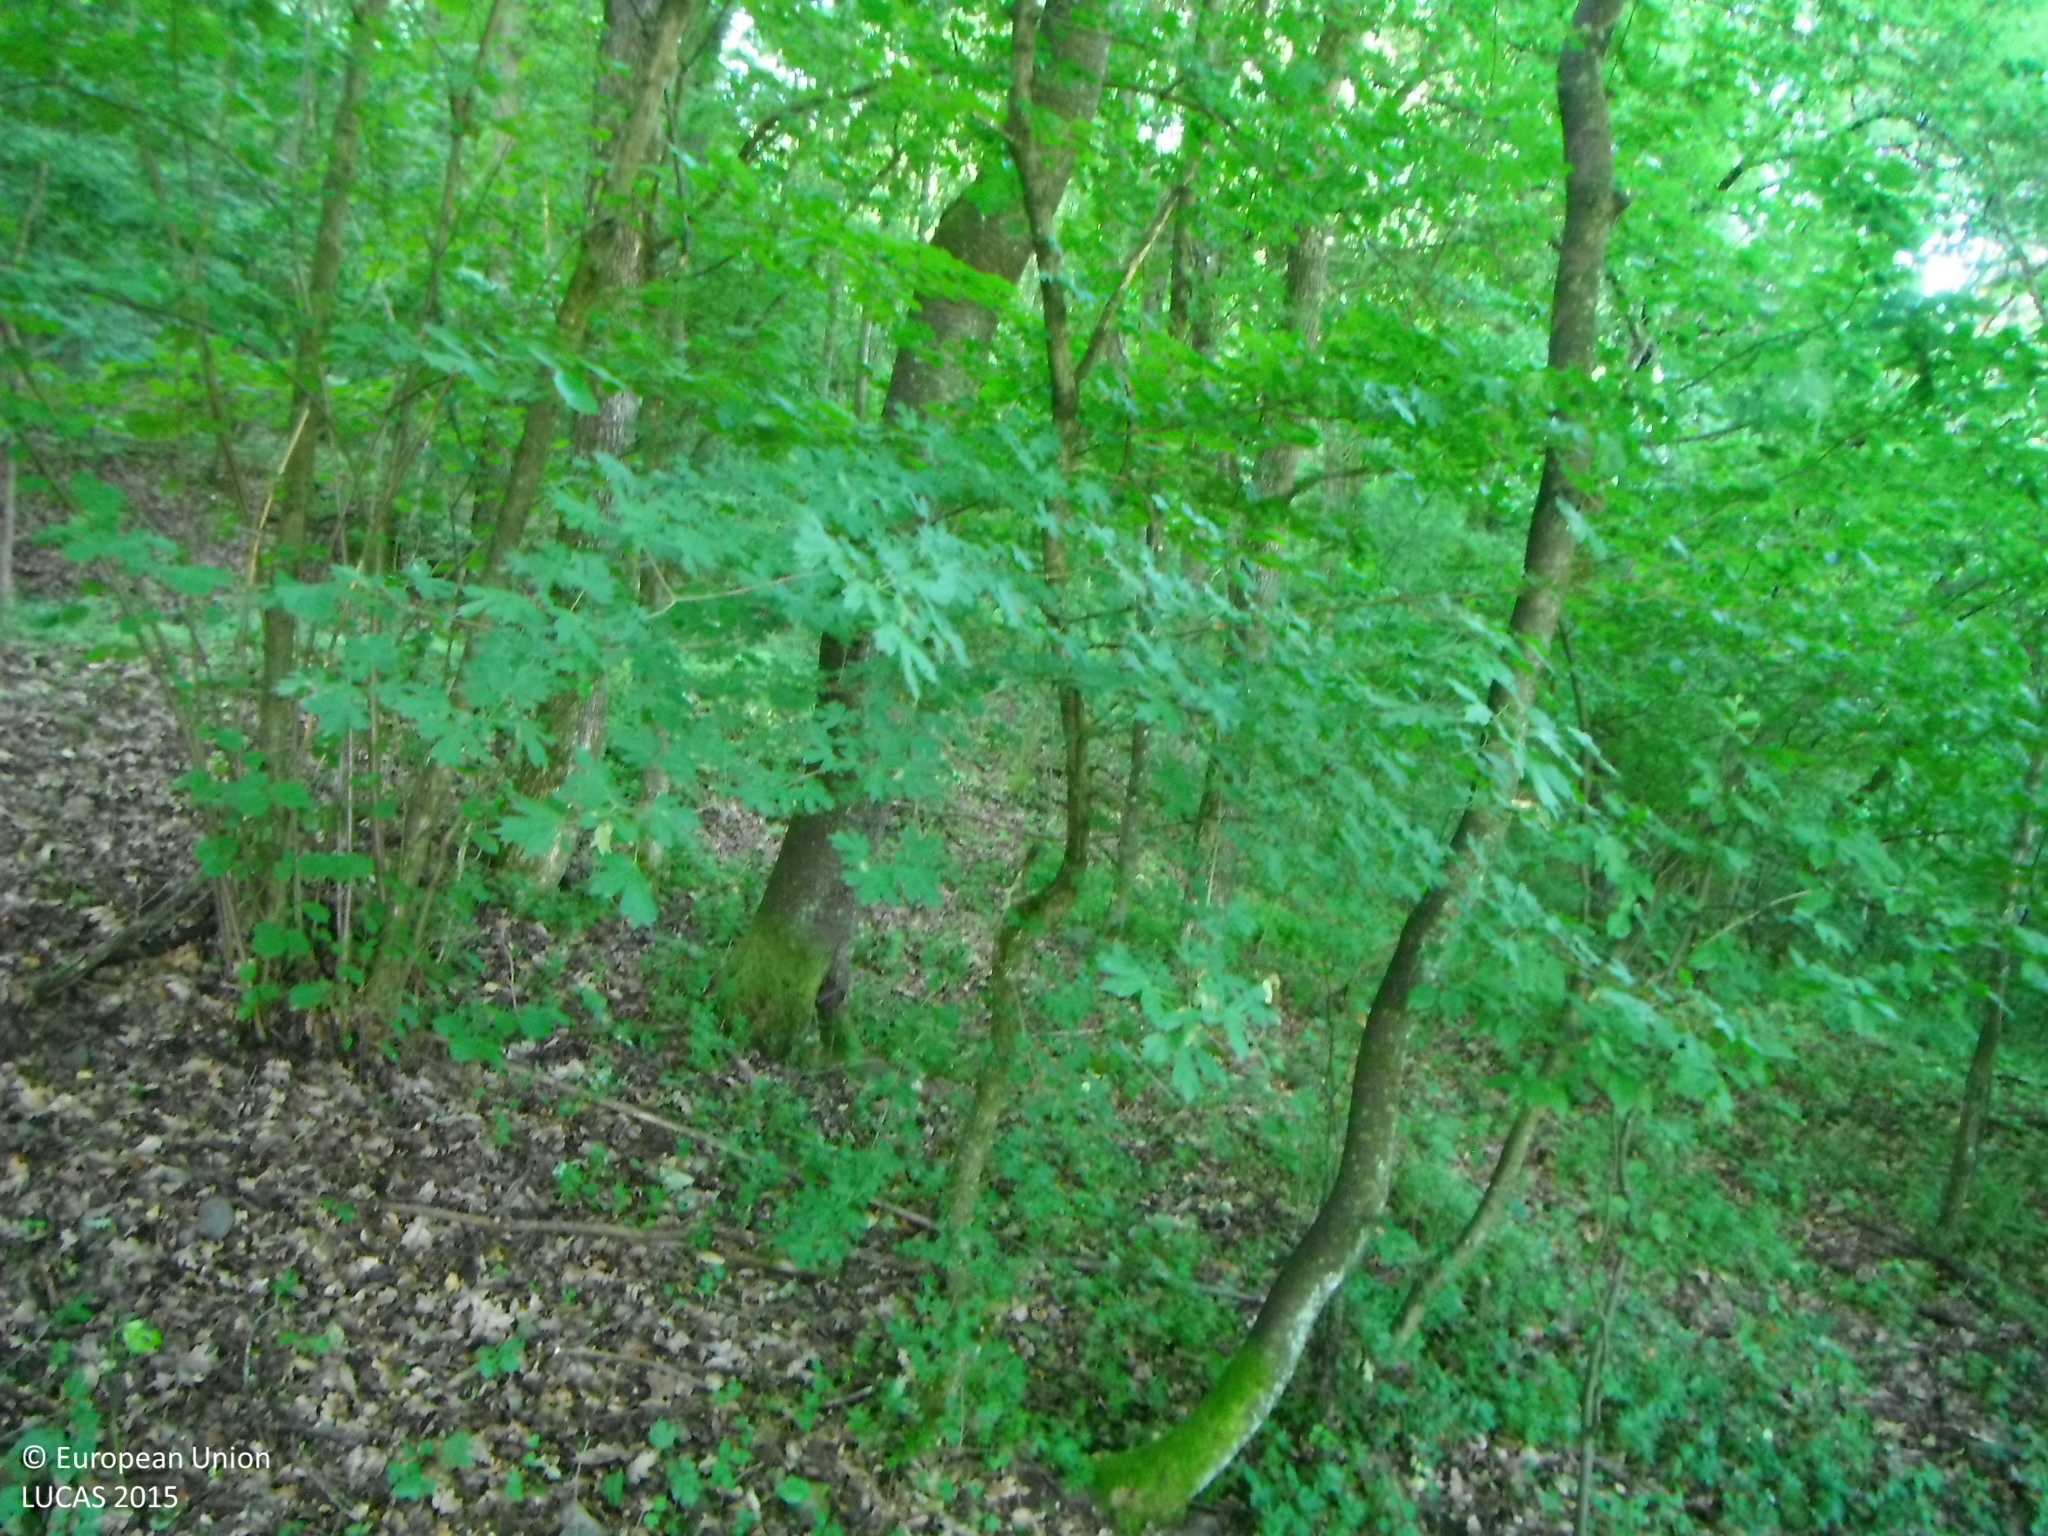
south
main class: Woodland
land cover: Broadleaved woodland
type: mesophytic deciduous forest
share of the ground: > 75 %
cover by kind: broadleaved forest trees 100 %
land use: Forestry
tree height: > 5 m
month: June
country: SK
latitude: 48.2794
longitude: 18.8995
